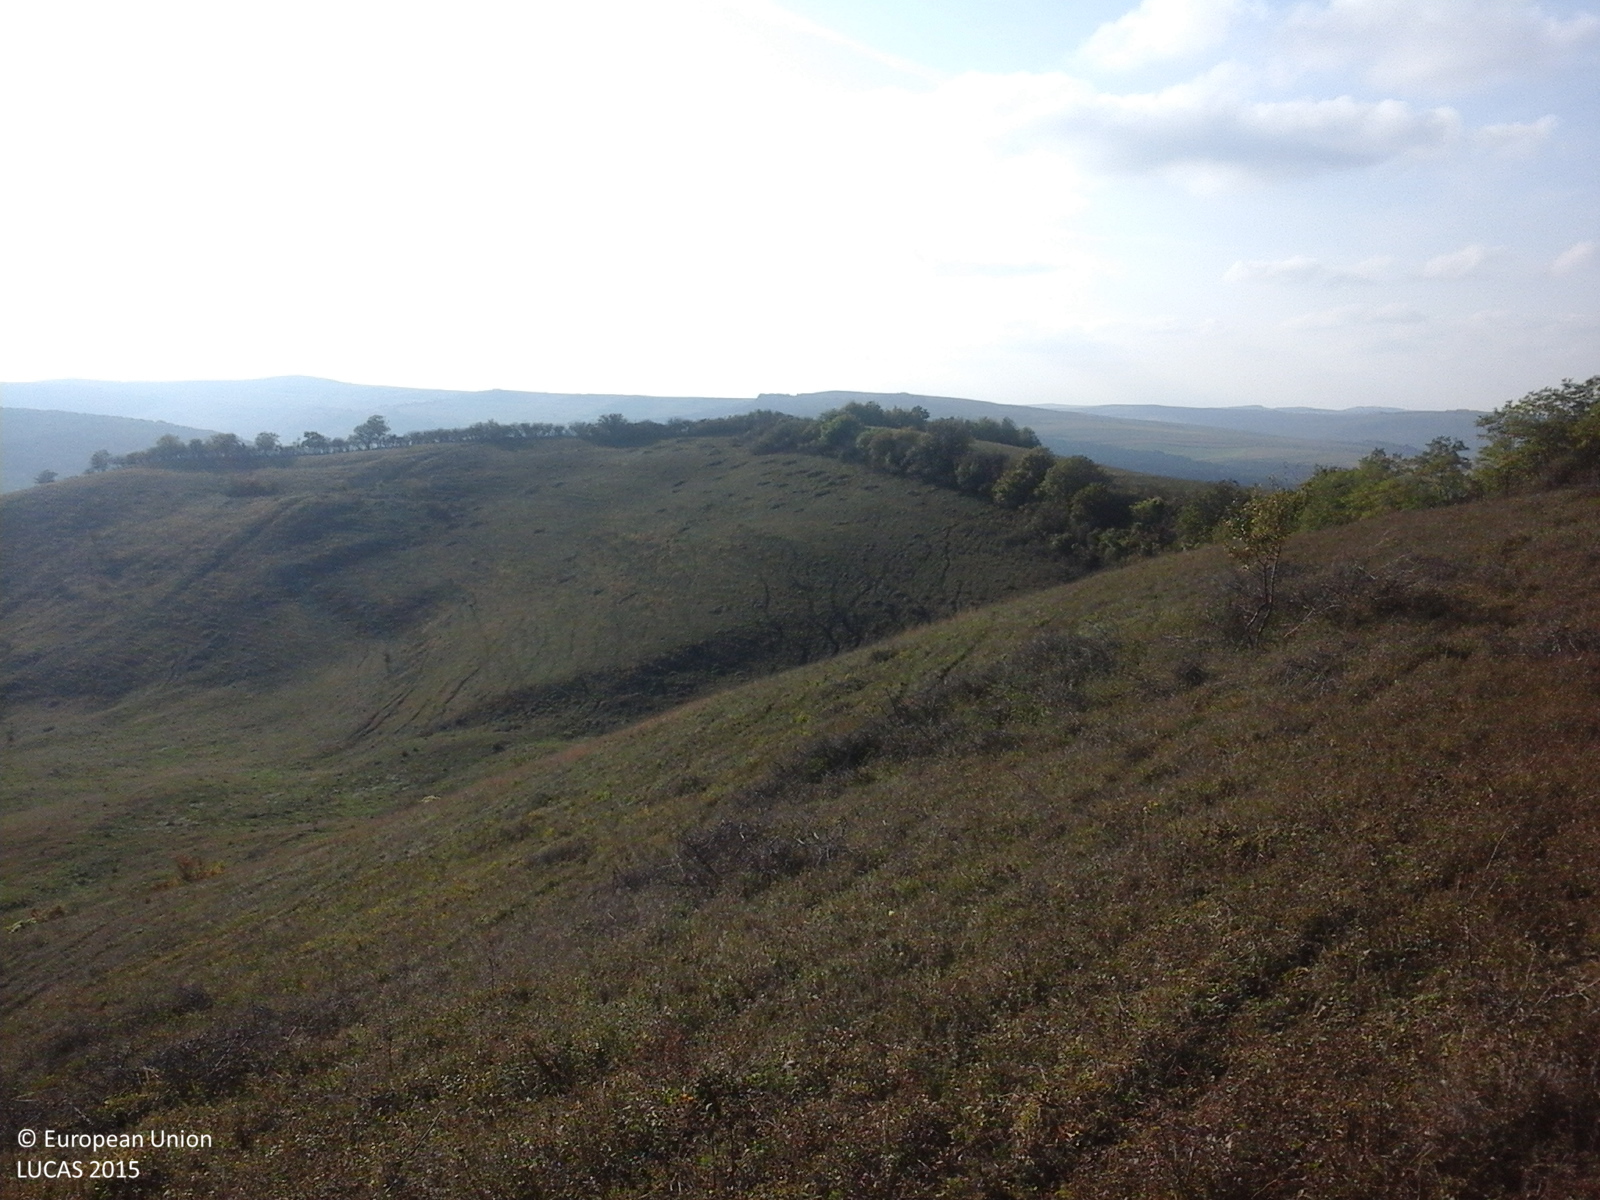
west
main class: Grassland
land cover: Grassland with sparse tree/shrub cover
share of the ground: > 75 %
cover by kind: herbaceous plants 95 %, broadleaved forest trees 5 %
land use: Agriculture (excluding fallow land and kitchen gardens)
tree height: < 5 m
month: October
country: RO
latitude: 46.3614
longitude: 24.1020
